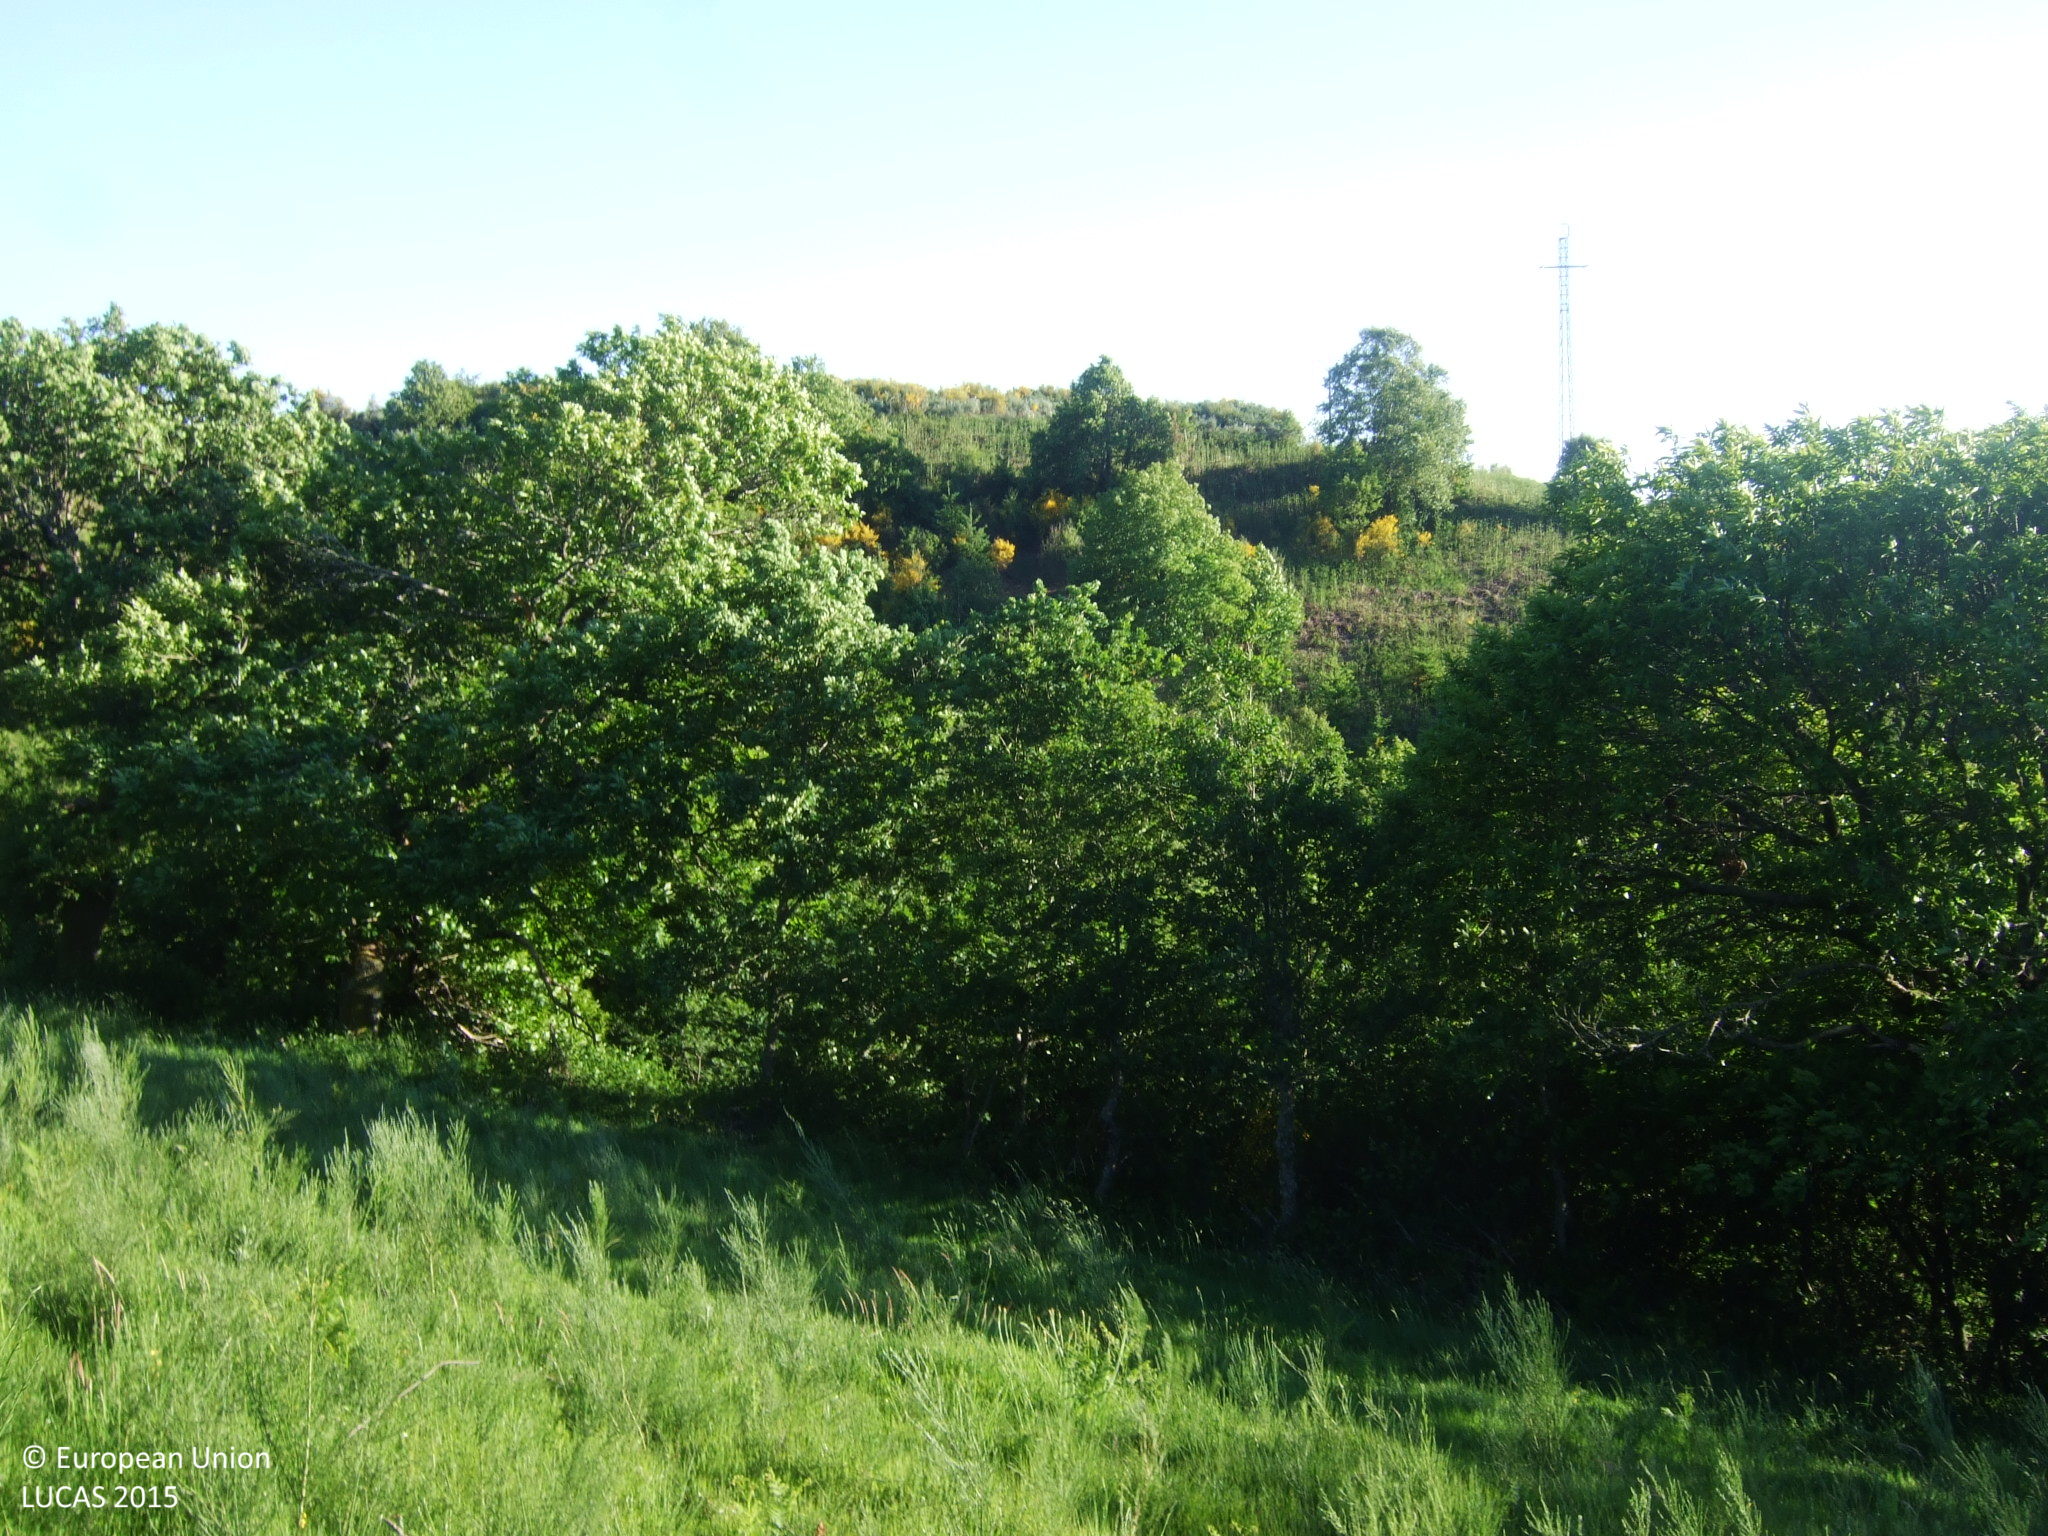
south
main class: Shrubland
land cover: Shrubland with sparse tree cover
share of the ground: > 75 %
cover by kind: shrubs 50 %, herbaceous plants 45 %, broadleaved forest trees 5 %
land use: Agriculture (excluding fallow land and kitchen gardens)
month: May
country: ES
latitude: 42.6796
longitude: -7.3099
